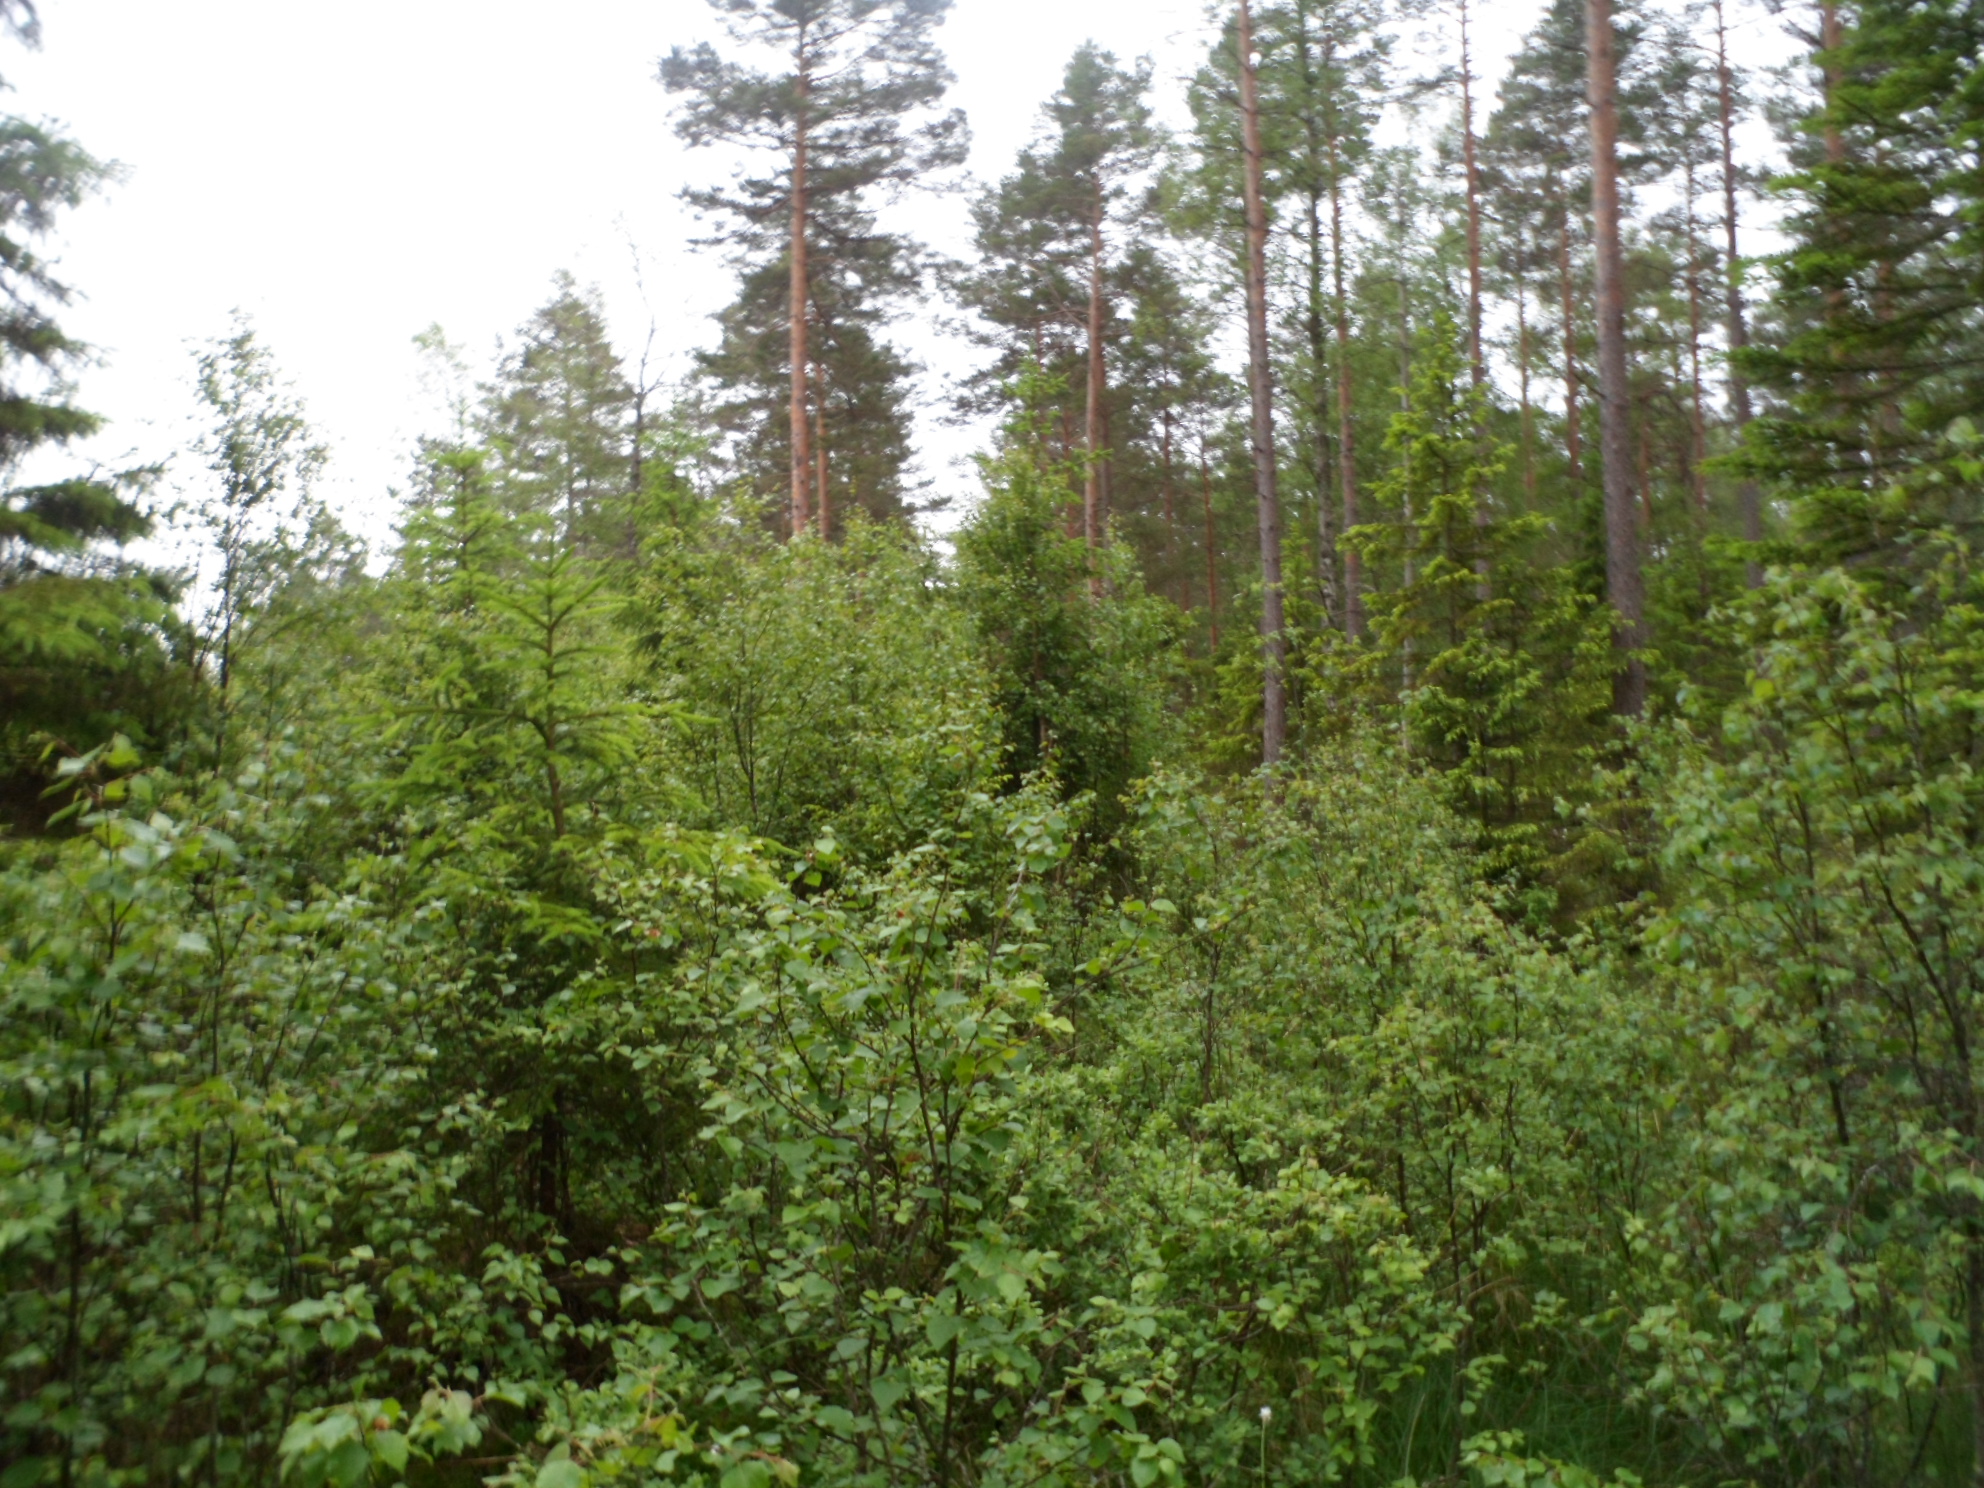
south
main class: Woodland
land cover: Spruce dominated mixed woodland
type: boreal forest
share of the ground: 50 - 75 %
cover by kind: coniferous forest trees 30 %, broadleaved forest trees 30 %, shrubs 20 %, herbaceous plants 10 %, lichens and mosses 10 %
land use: Forestry
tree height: > 5 m
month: June
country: SE
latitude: 57.0506
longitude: 15.3222
